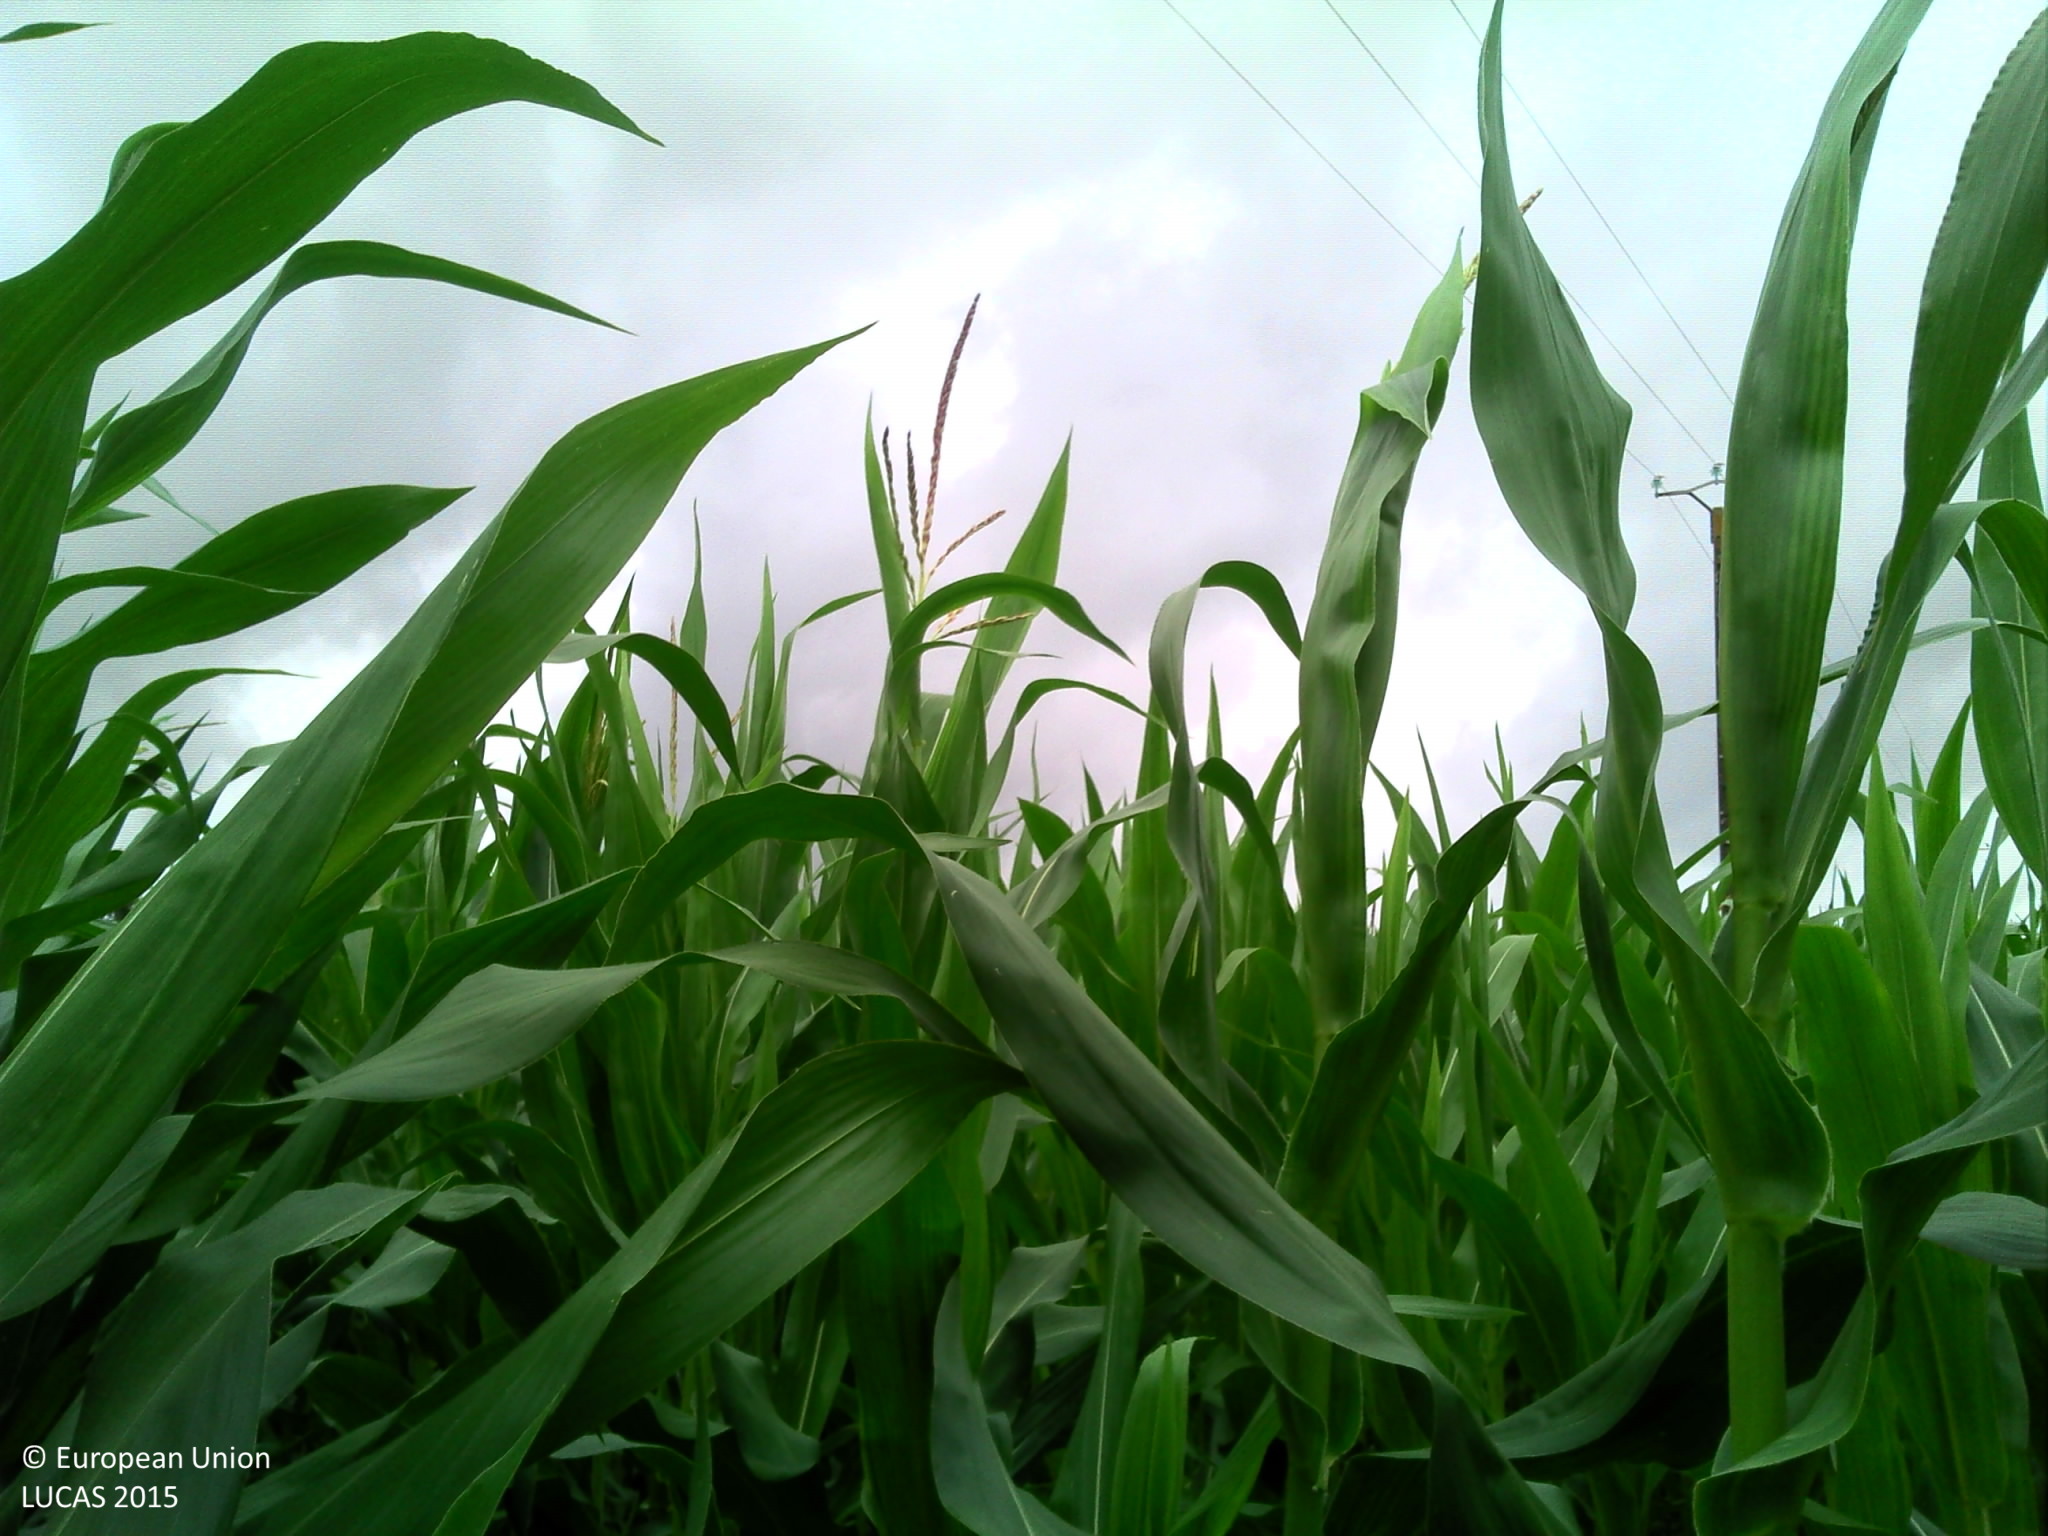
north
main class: Cropland
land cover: Maize
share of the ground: 50 - 75 %
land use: Agriculture (excluding fallow land and kitchen gardens)
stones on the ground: 10 - 25 %
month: July
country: FR
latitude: 48.2407
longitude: -3.0913
